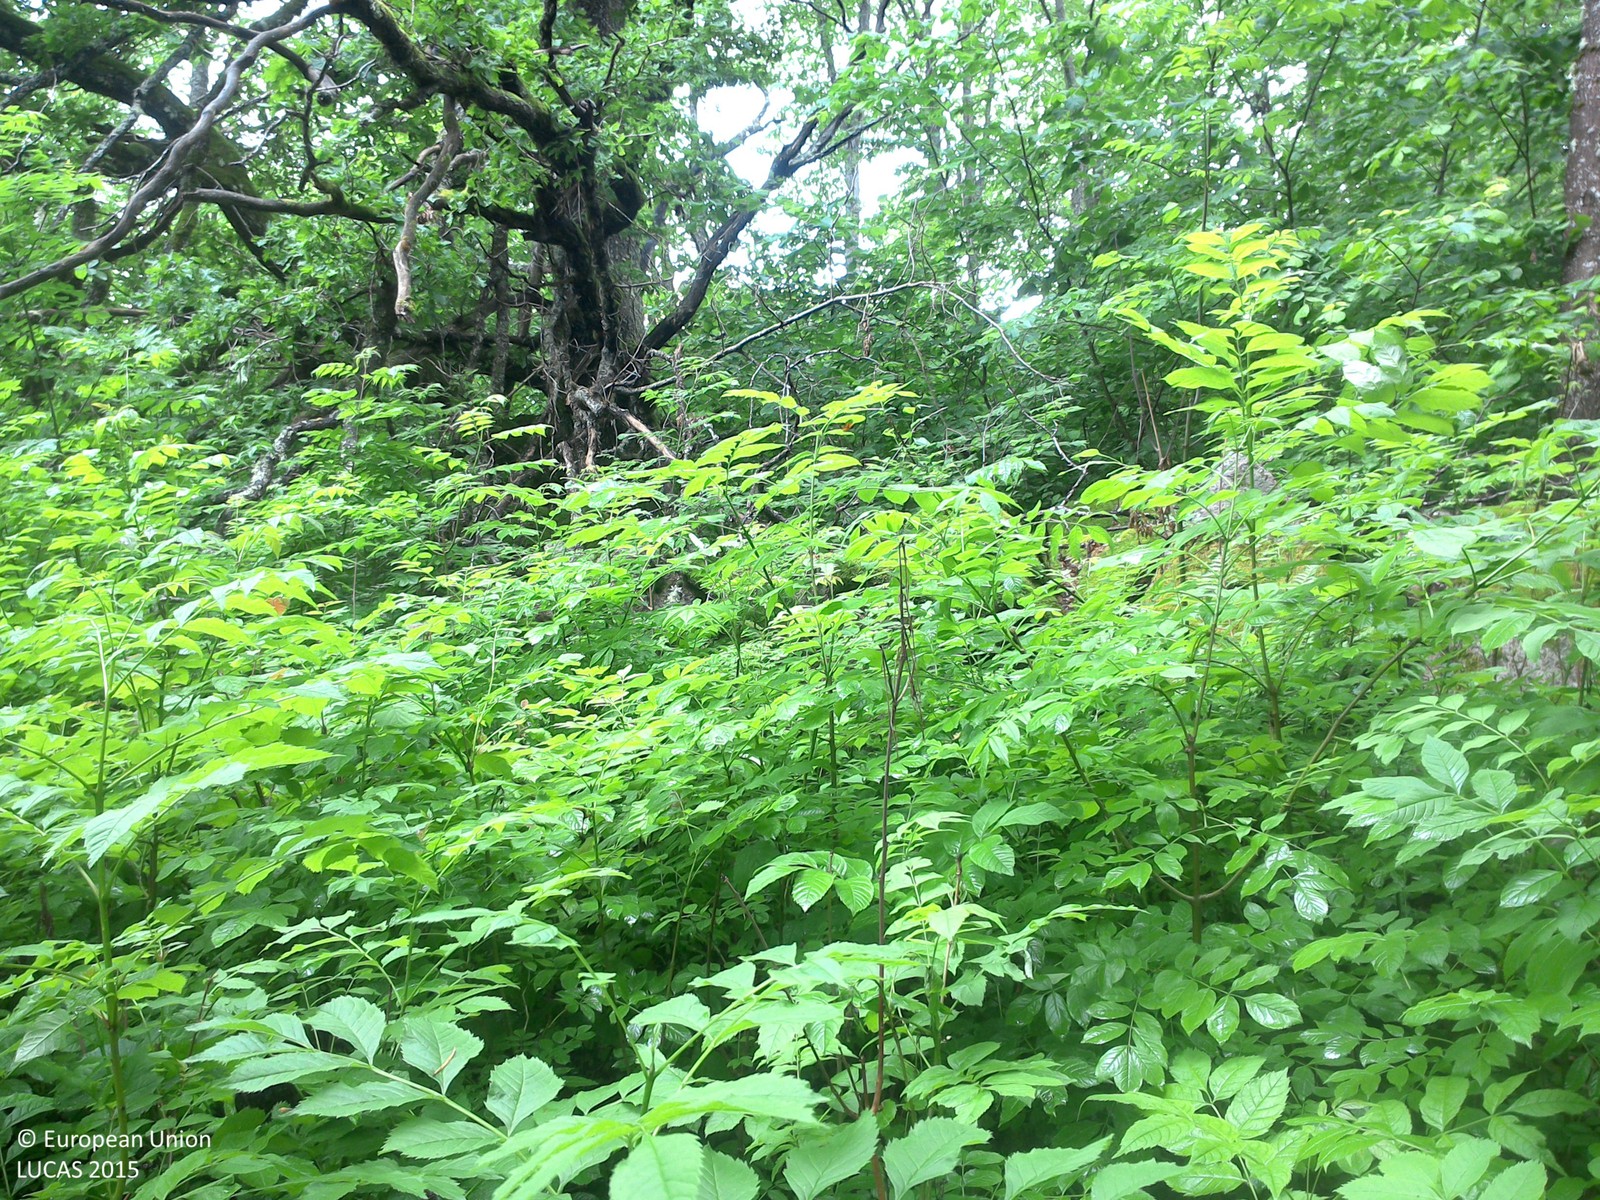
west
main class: Woodland
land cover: Broadleaved woodland
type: boreal forest
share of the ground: > 75 %
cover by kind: broadleaved forest trees 75 %, herbaceous plants 25 %
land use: Forestry
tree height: > 5 m
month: June
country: SE
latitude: 58.0665
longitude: 15.6062
